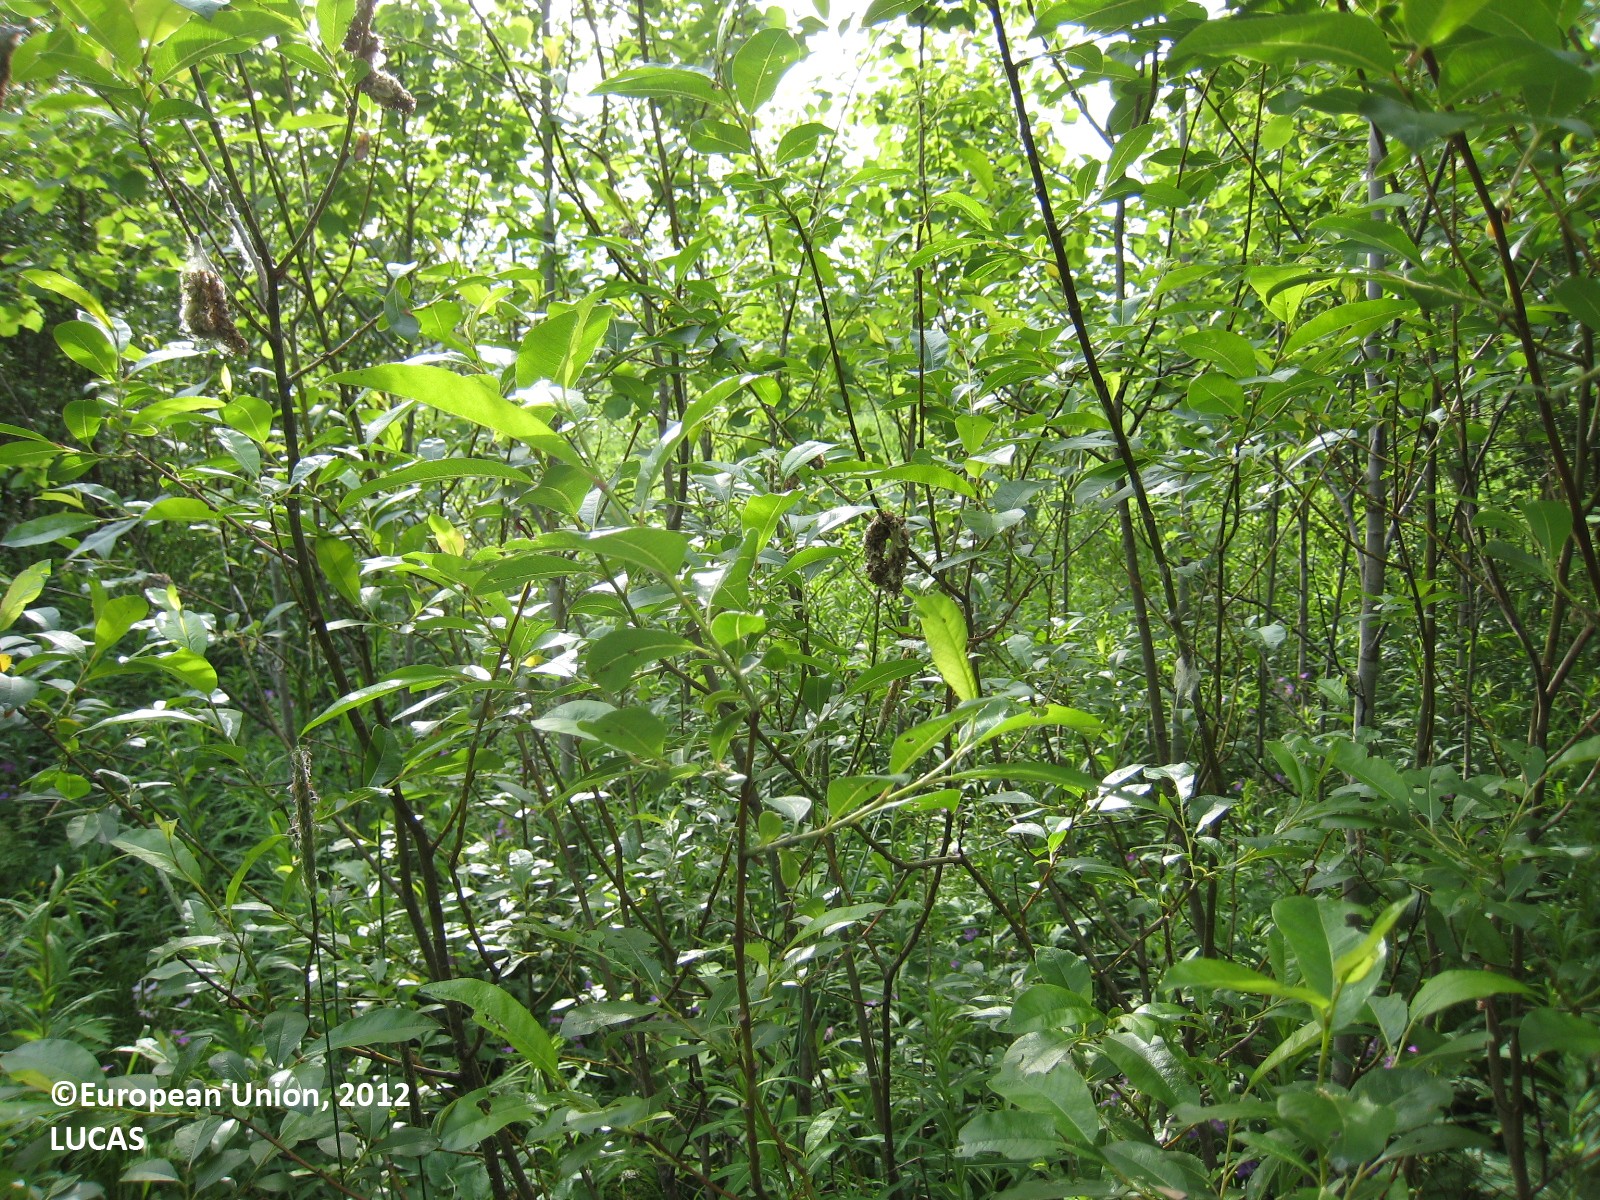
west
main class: Woodland
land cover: Broadleaved woodland
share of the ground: > 75 %
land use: Semi-natural and natural areas not in use
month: June
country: FI
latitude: 62.4545
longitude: 25.9596
